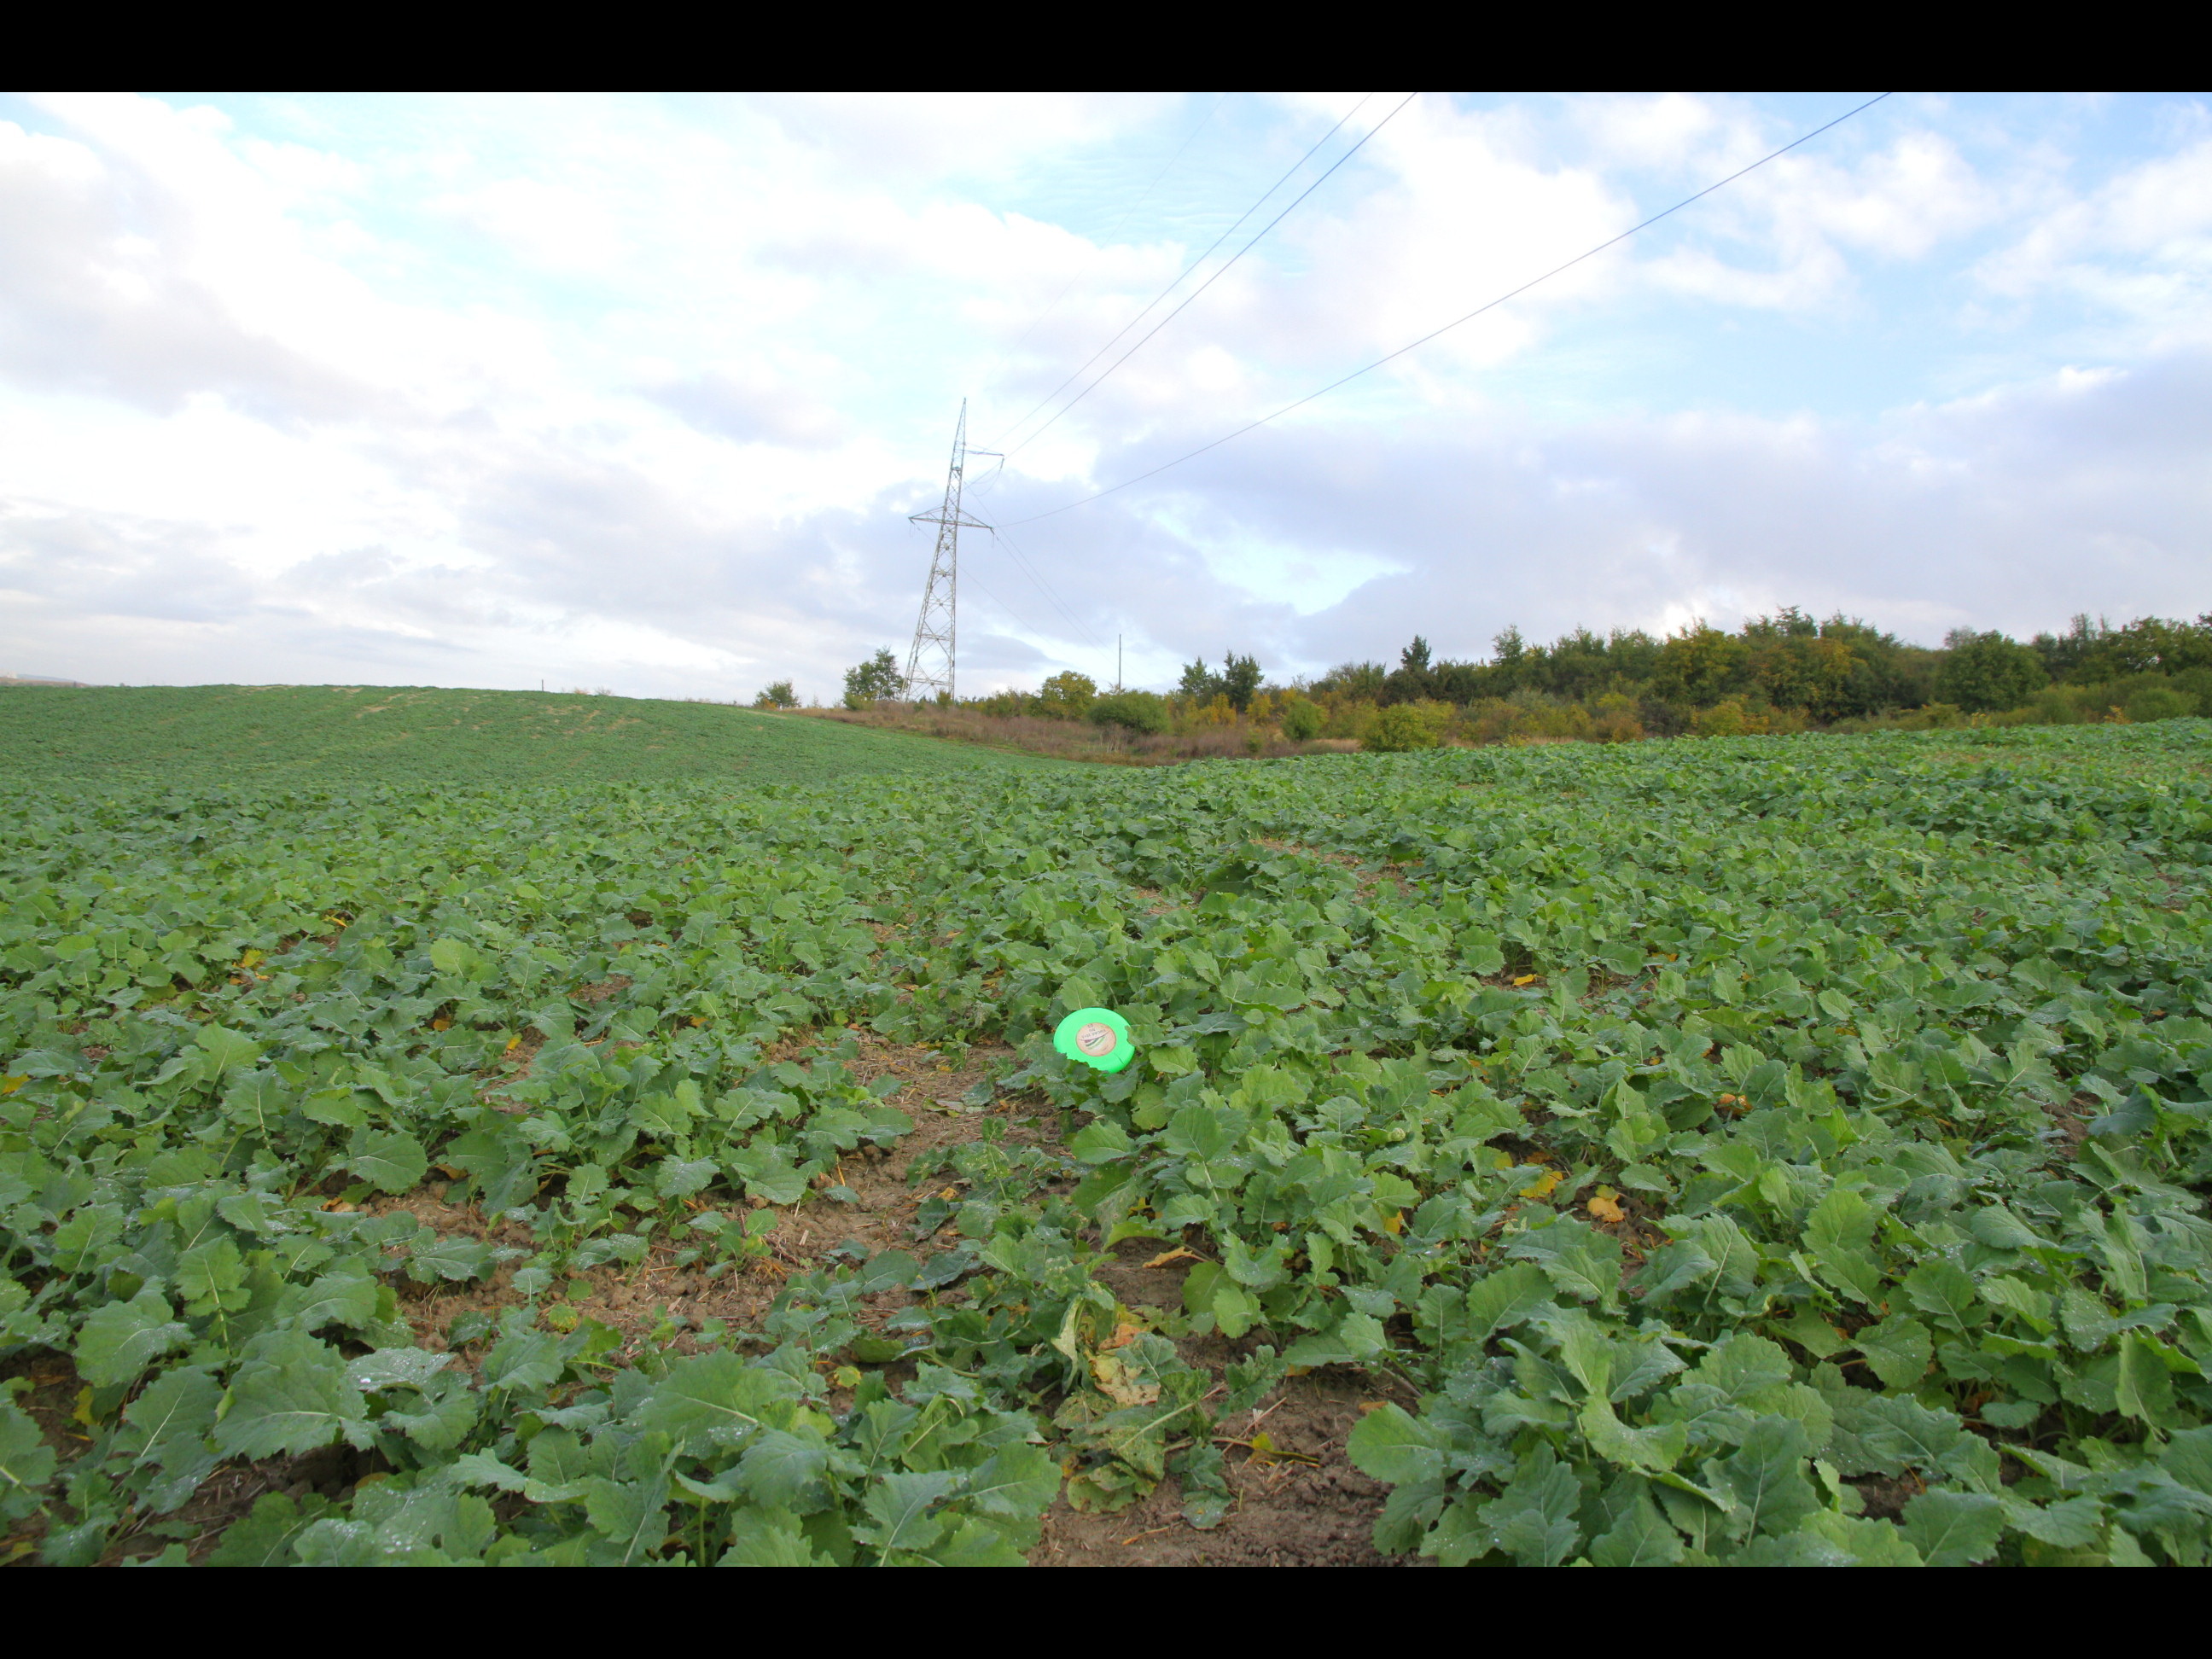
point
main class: Cropland
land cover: Rape and turnip rape
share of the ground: > 75 %
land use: Agriculture (excluding fallow land and kitchen gardens)
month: October
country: BG
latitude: 43.2265
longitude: 27.0190
